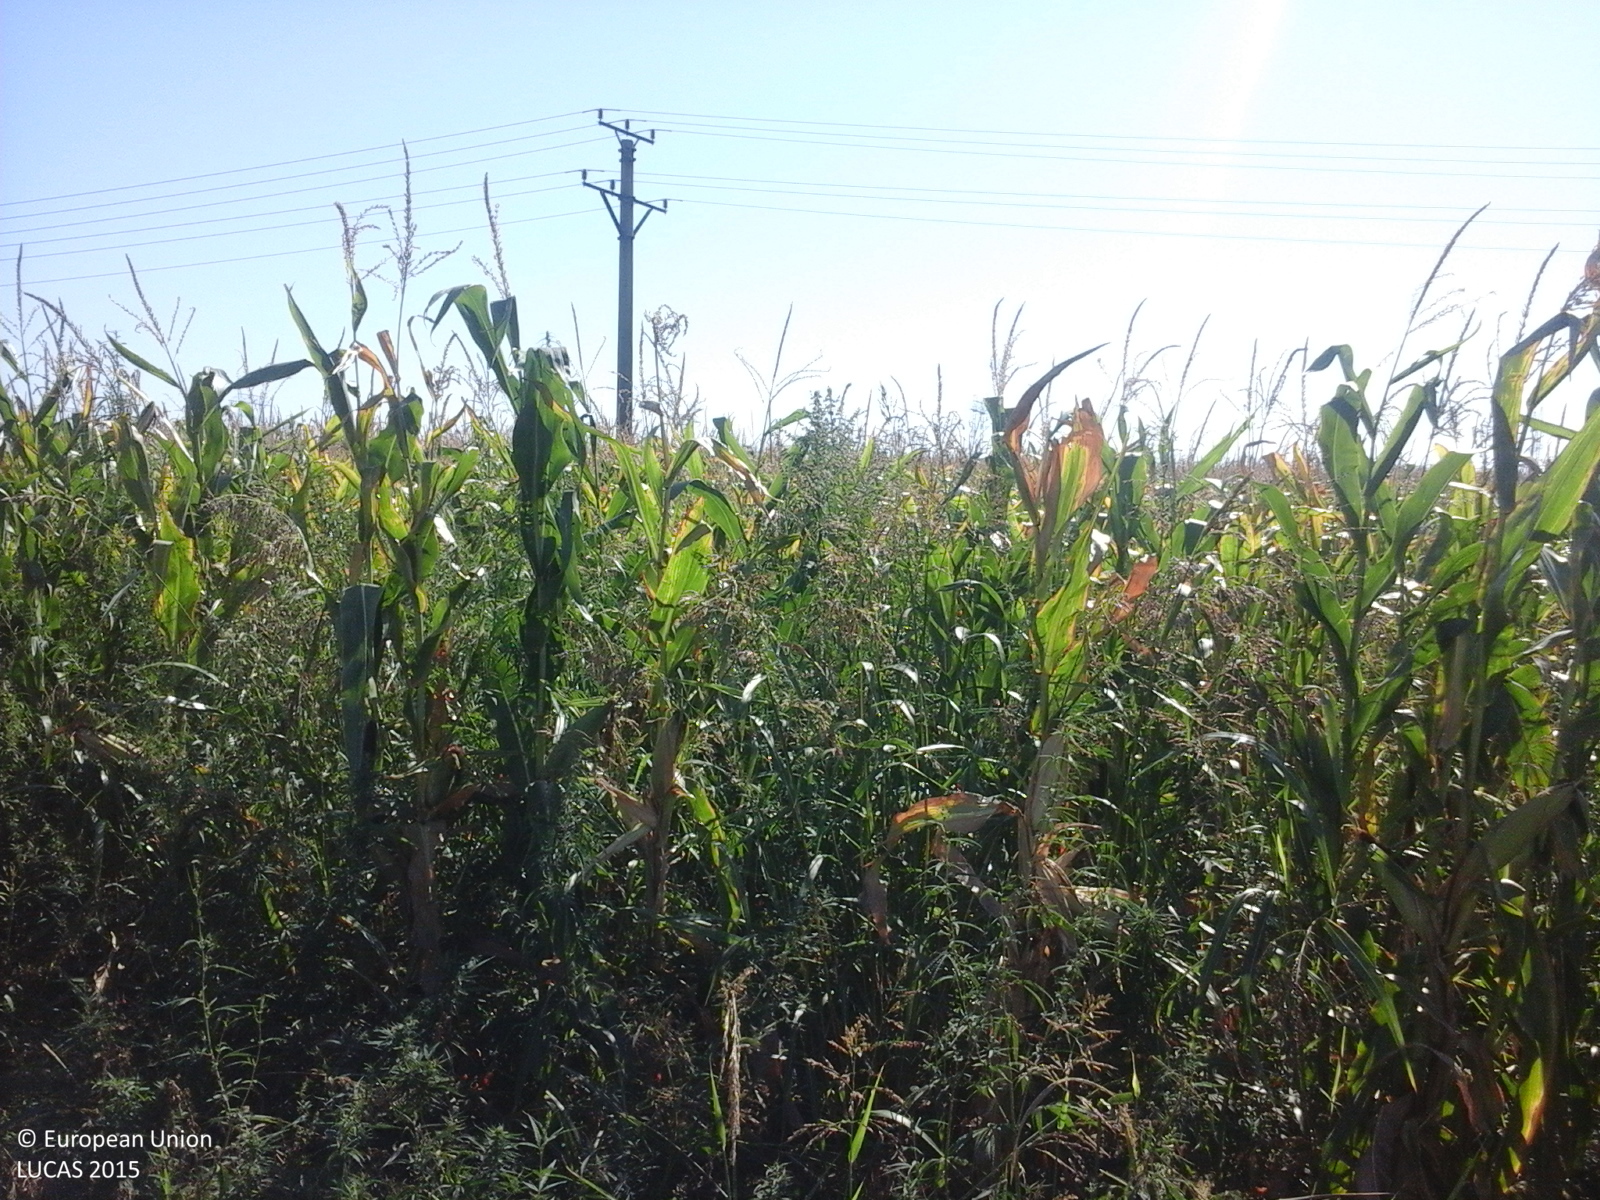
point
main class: Cropland
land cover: Maize
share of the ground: > 75 %
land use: Agriculture (excluding fallow land and kitchen gardens)
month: August
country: RO
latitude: 44.6595
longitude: 28.2133
